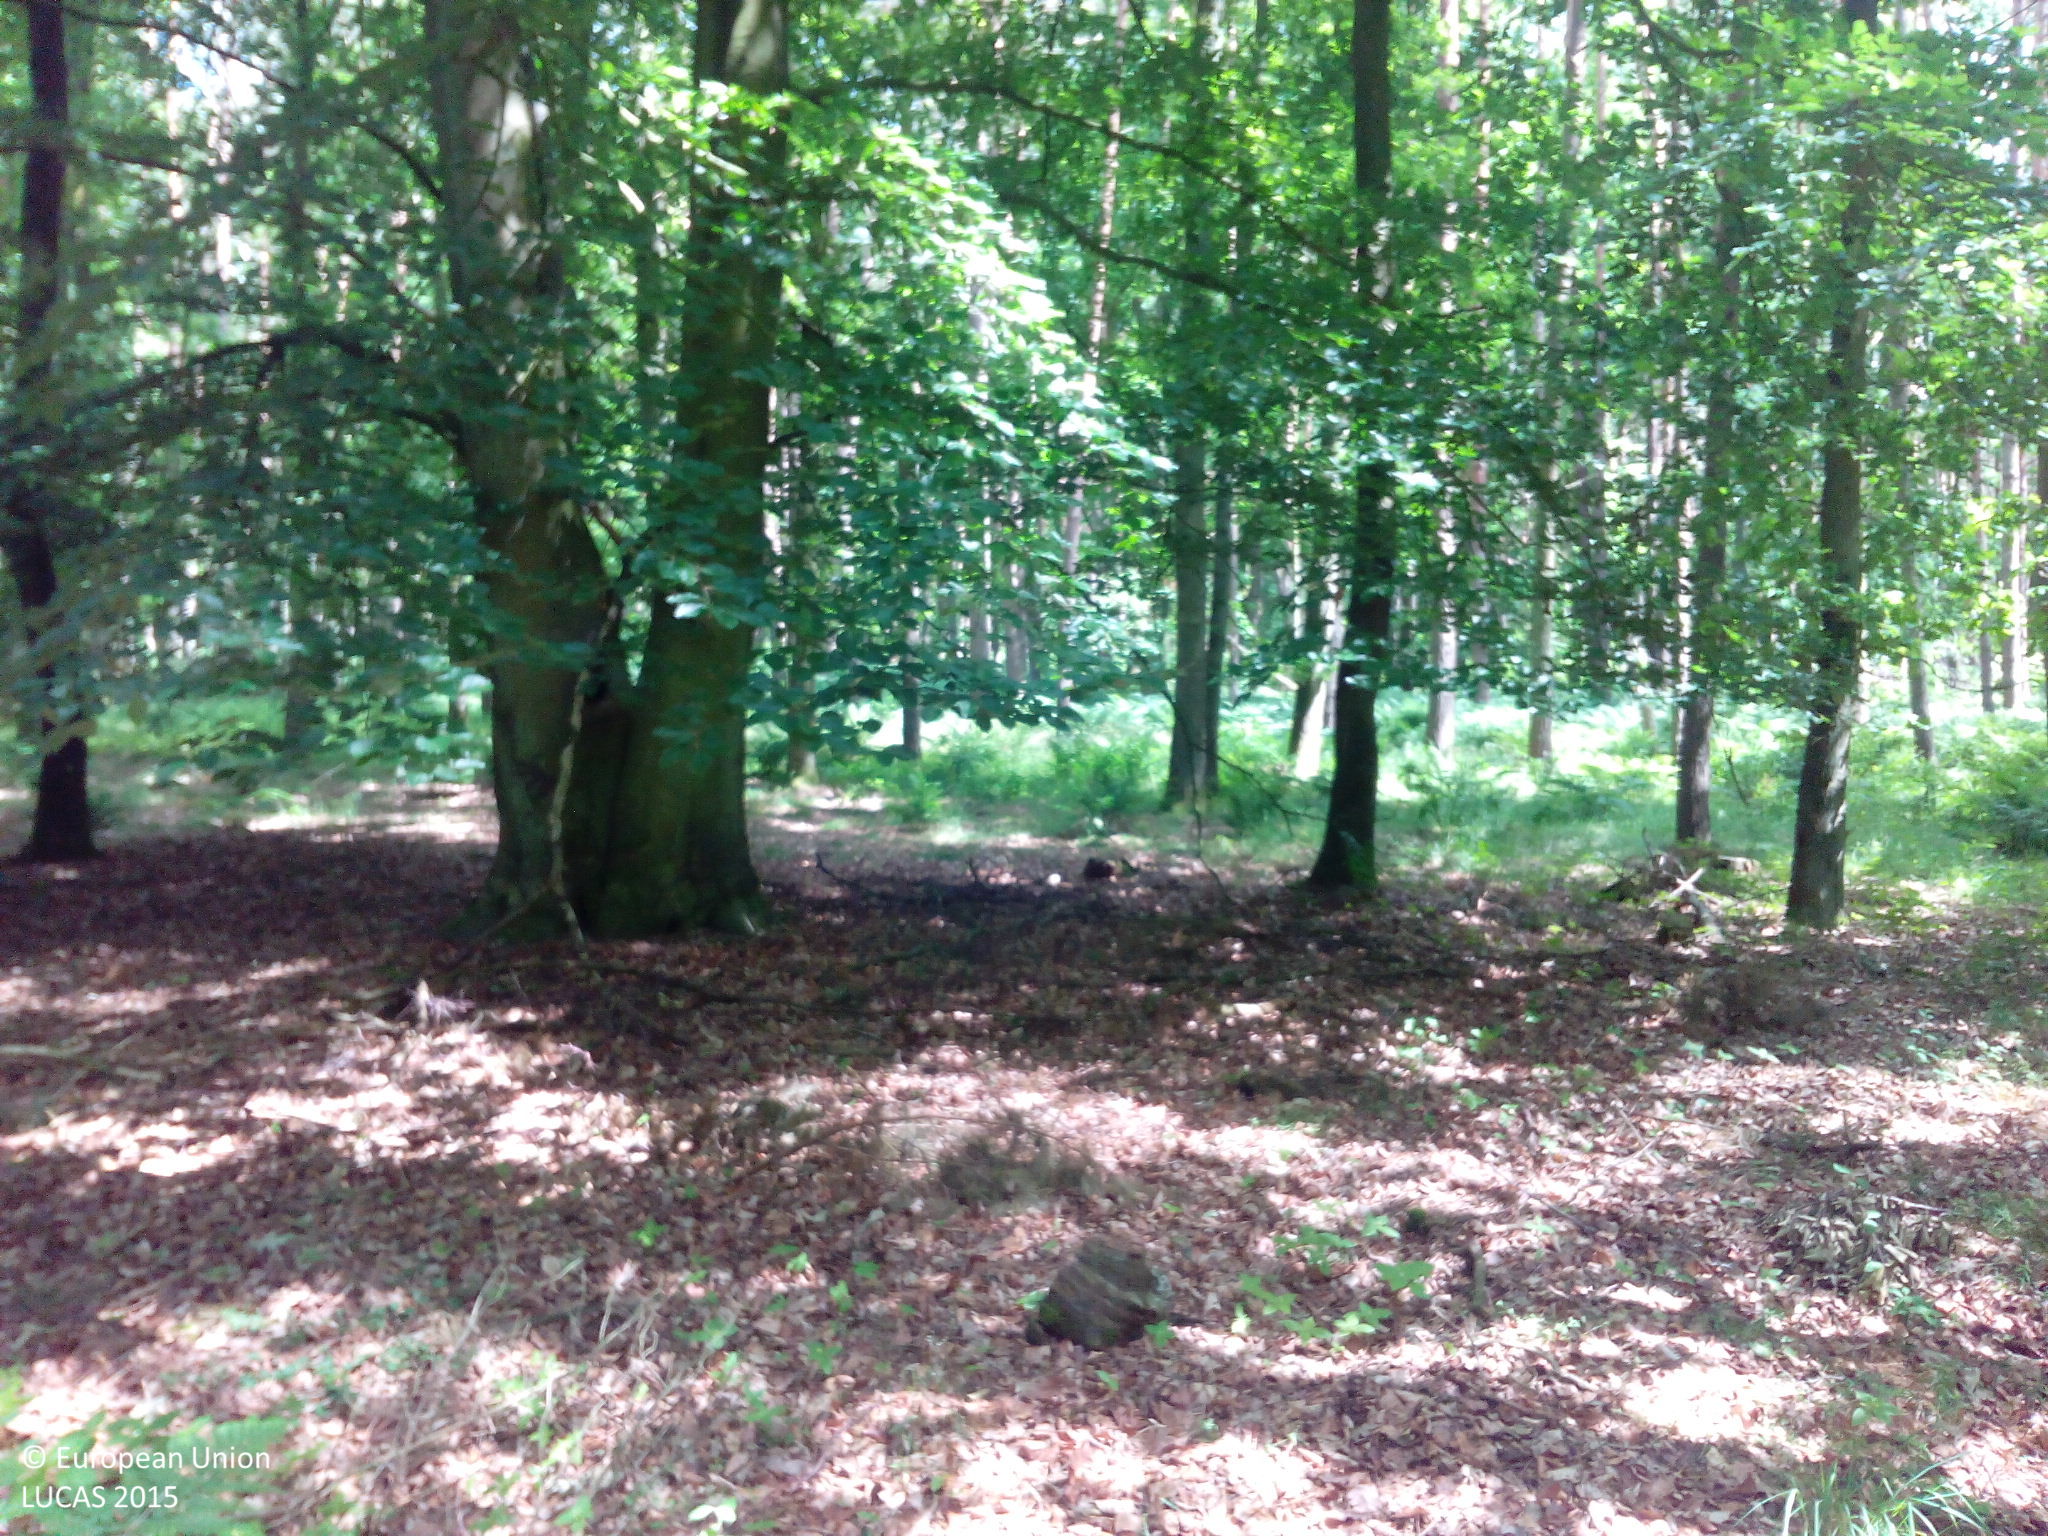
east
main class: Woodland
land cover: Pine dominated mixed woodland
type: hemiboreal forest and nemoral coniferous forest and mixed broadleaved-coniferous forest
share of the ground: > 75 %
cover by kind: coniferous forest trees 50 %, broadleaved forest trees 30 %, unconsolidated bare surface 10 %, shrubs 5 %, herbaceous plants 5 %
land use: Forestry
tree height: > 5 m
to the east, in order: Pine dominated mixed woodland; Tracks
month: June
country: DE
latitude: 53.8459
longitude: 11.1394
